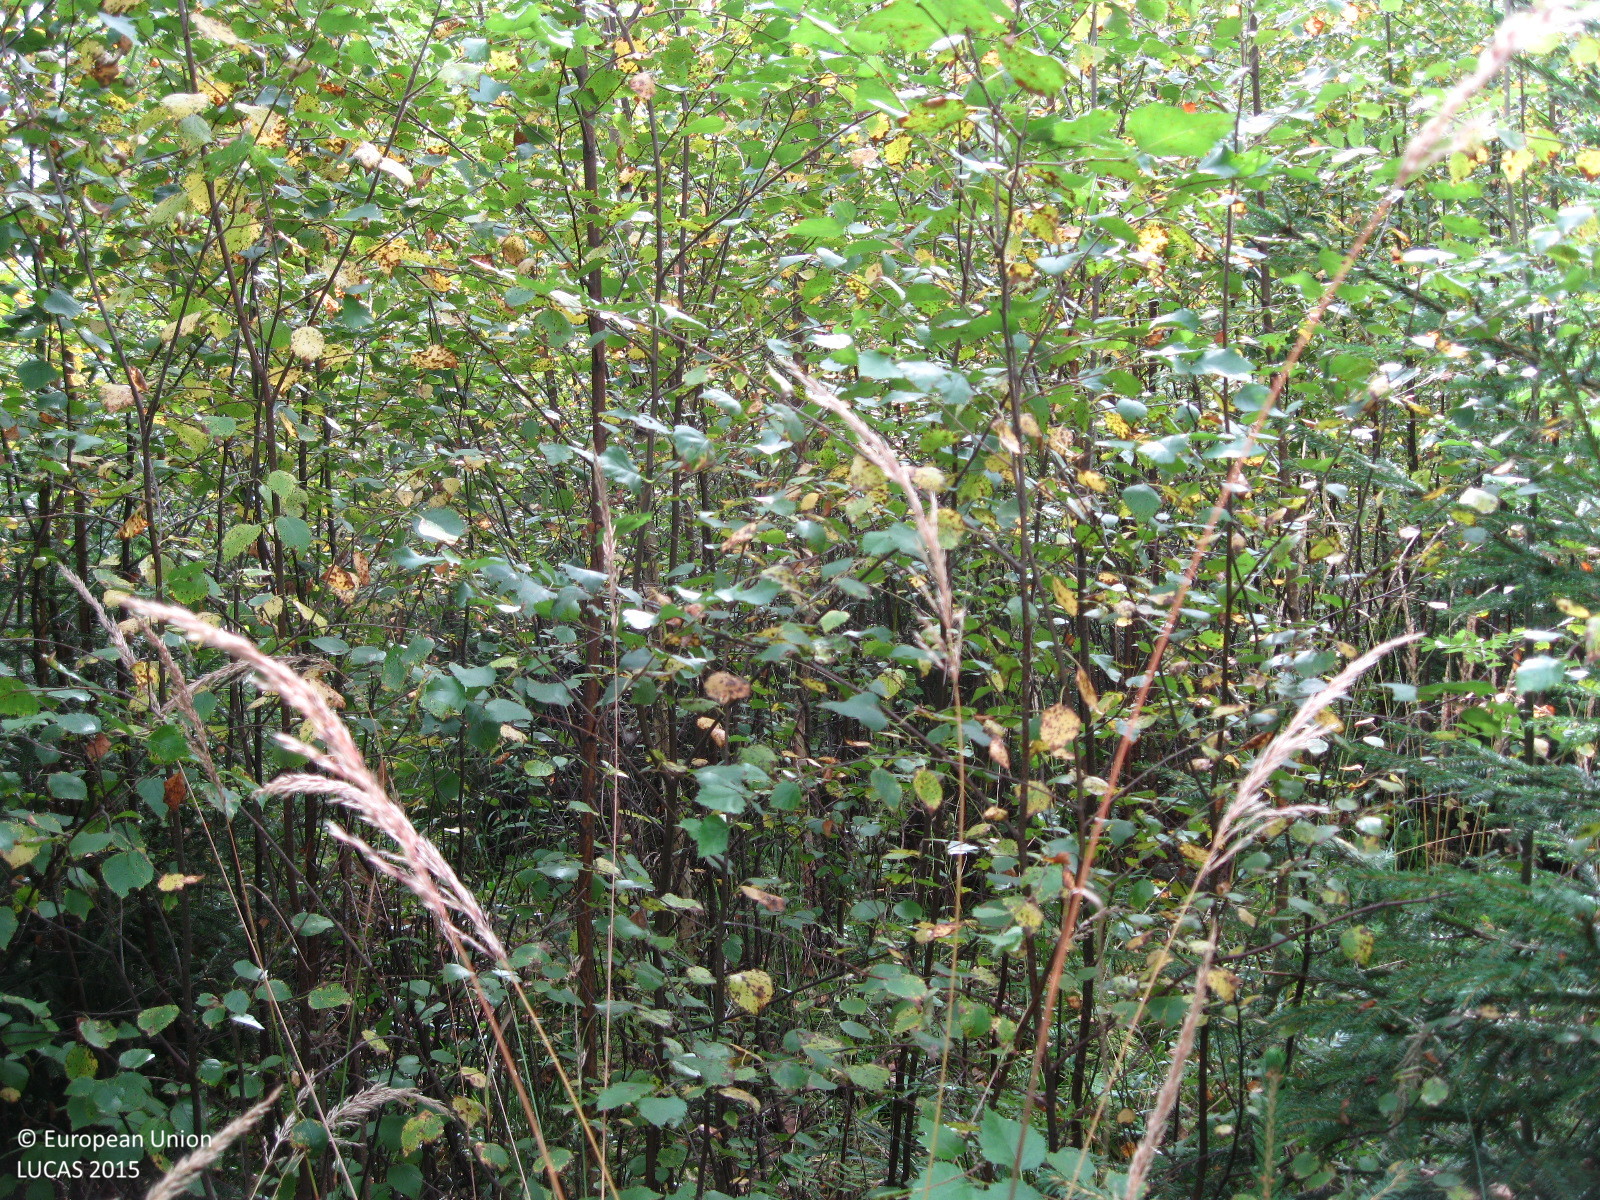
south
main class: Woodland
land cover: Spruce dominated mixed woodland
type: boreal forest
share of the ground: > 75 %
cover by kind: coniferous forest trees 45 %, broadleaved forest trees 35 %, shrubs 10 %, herbaceous plants 10 %
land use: Forestry
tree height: > 5 m
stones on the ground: < 10 %
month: September
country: FI
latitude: 60.7196
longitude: 24.9431
